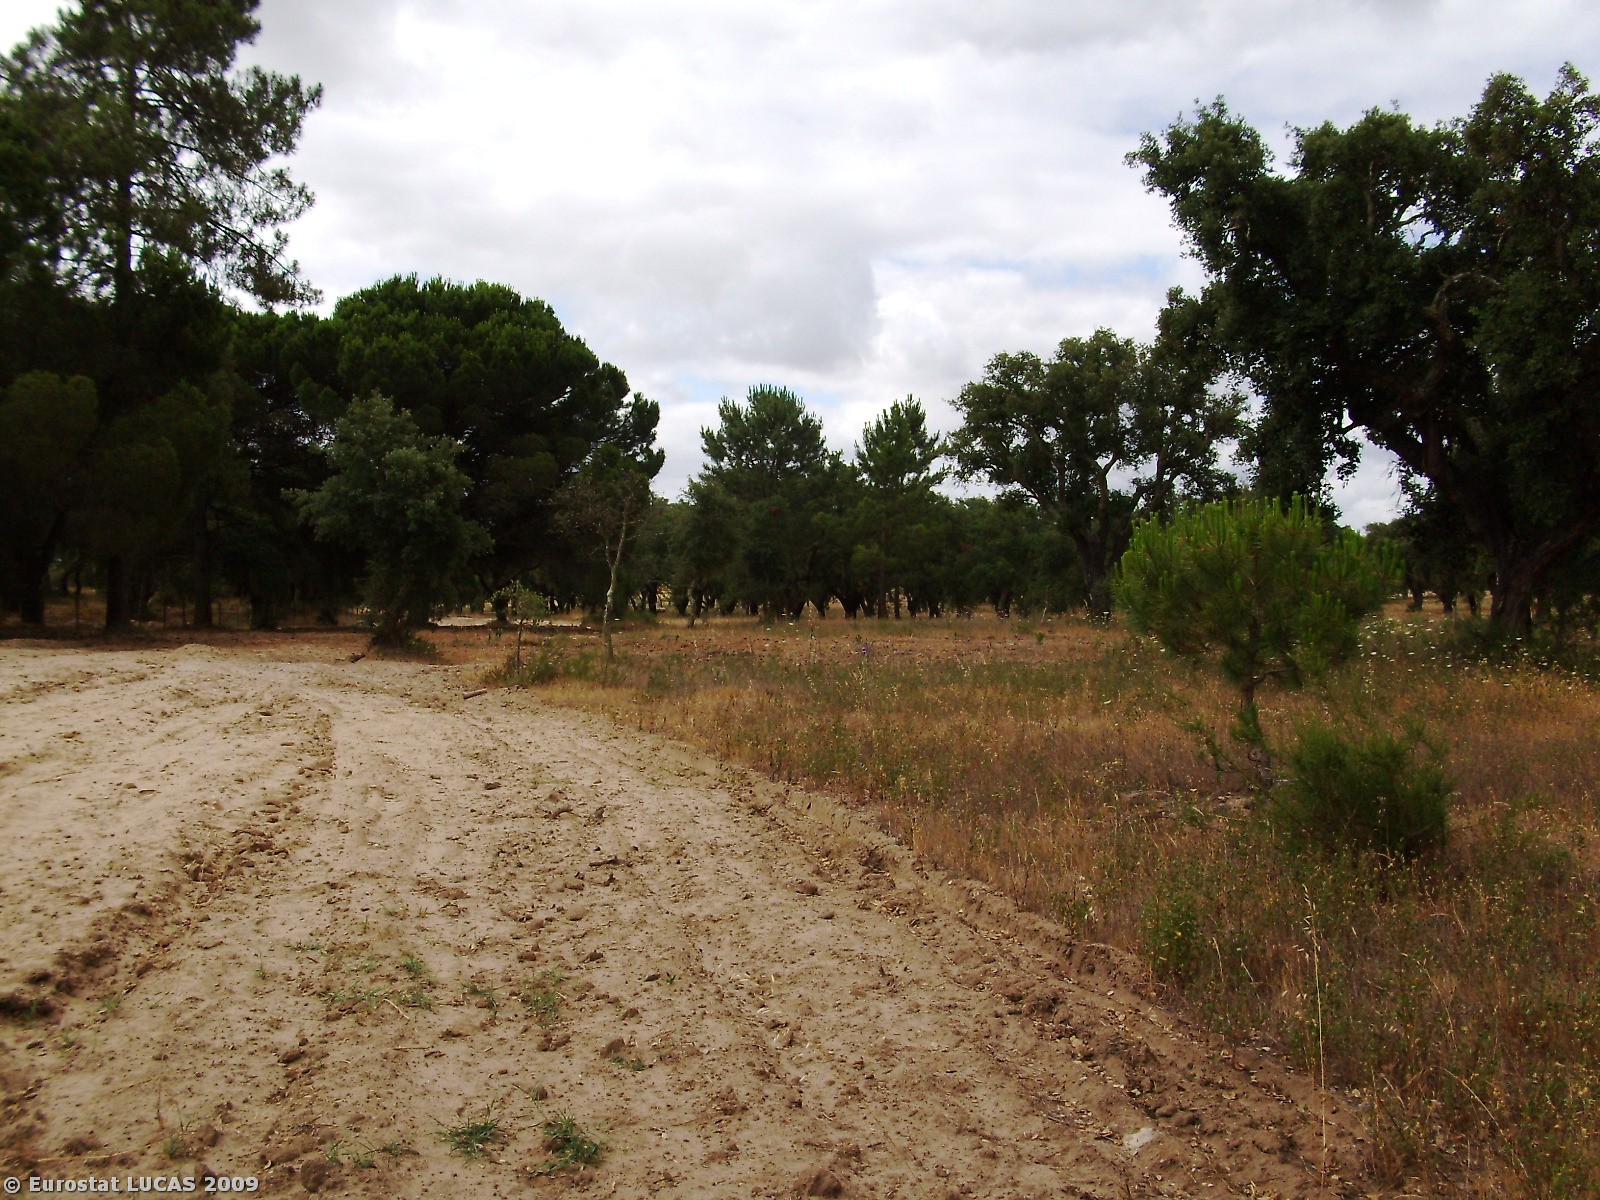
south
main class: Woodland
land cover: Broadleaved woodland
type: broadleaved evergreen forest
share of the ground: 10 - 25 %
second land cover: Bare land
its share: 10 - 25 %
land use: Forestry
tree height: > 5 m
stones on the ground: < 10 %
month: June
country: PT
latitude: 38.2976
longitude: -8.5395
